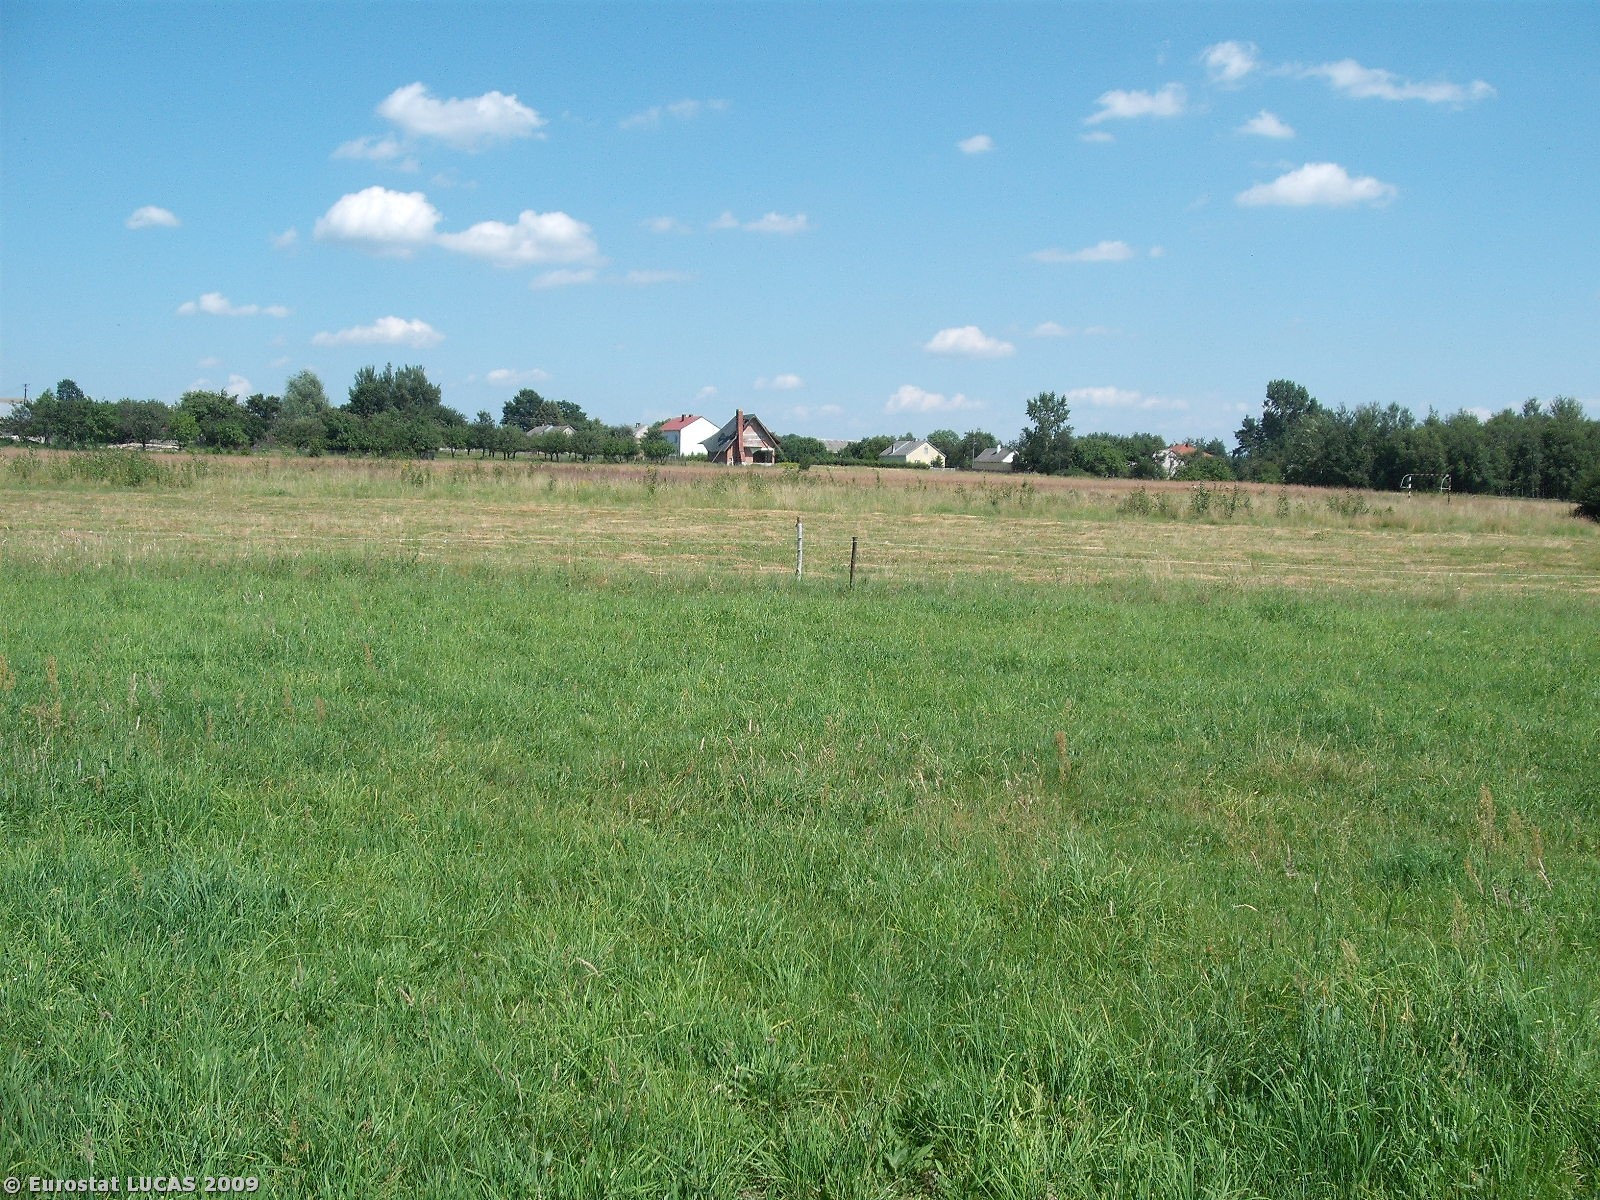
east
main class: Grassland
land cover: Grassland without tree/shrub cover
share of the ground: > 75 %
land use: Agriculture (excluding fallow land and kitchen gardens)
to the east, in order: Grassland without tree/shrub cover; Fences; Spontaneously vegetated surfaces; Triticale; Grassland without tree/shrub cover; Fences; Grassland without tree/shrub cover
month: July
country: PL
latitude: 50.6747
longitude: 20.7246
